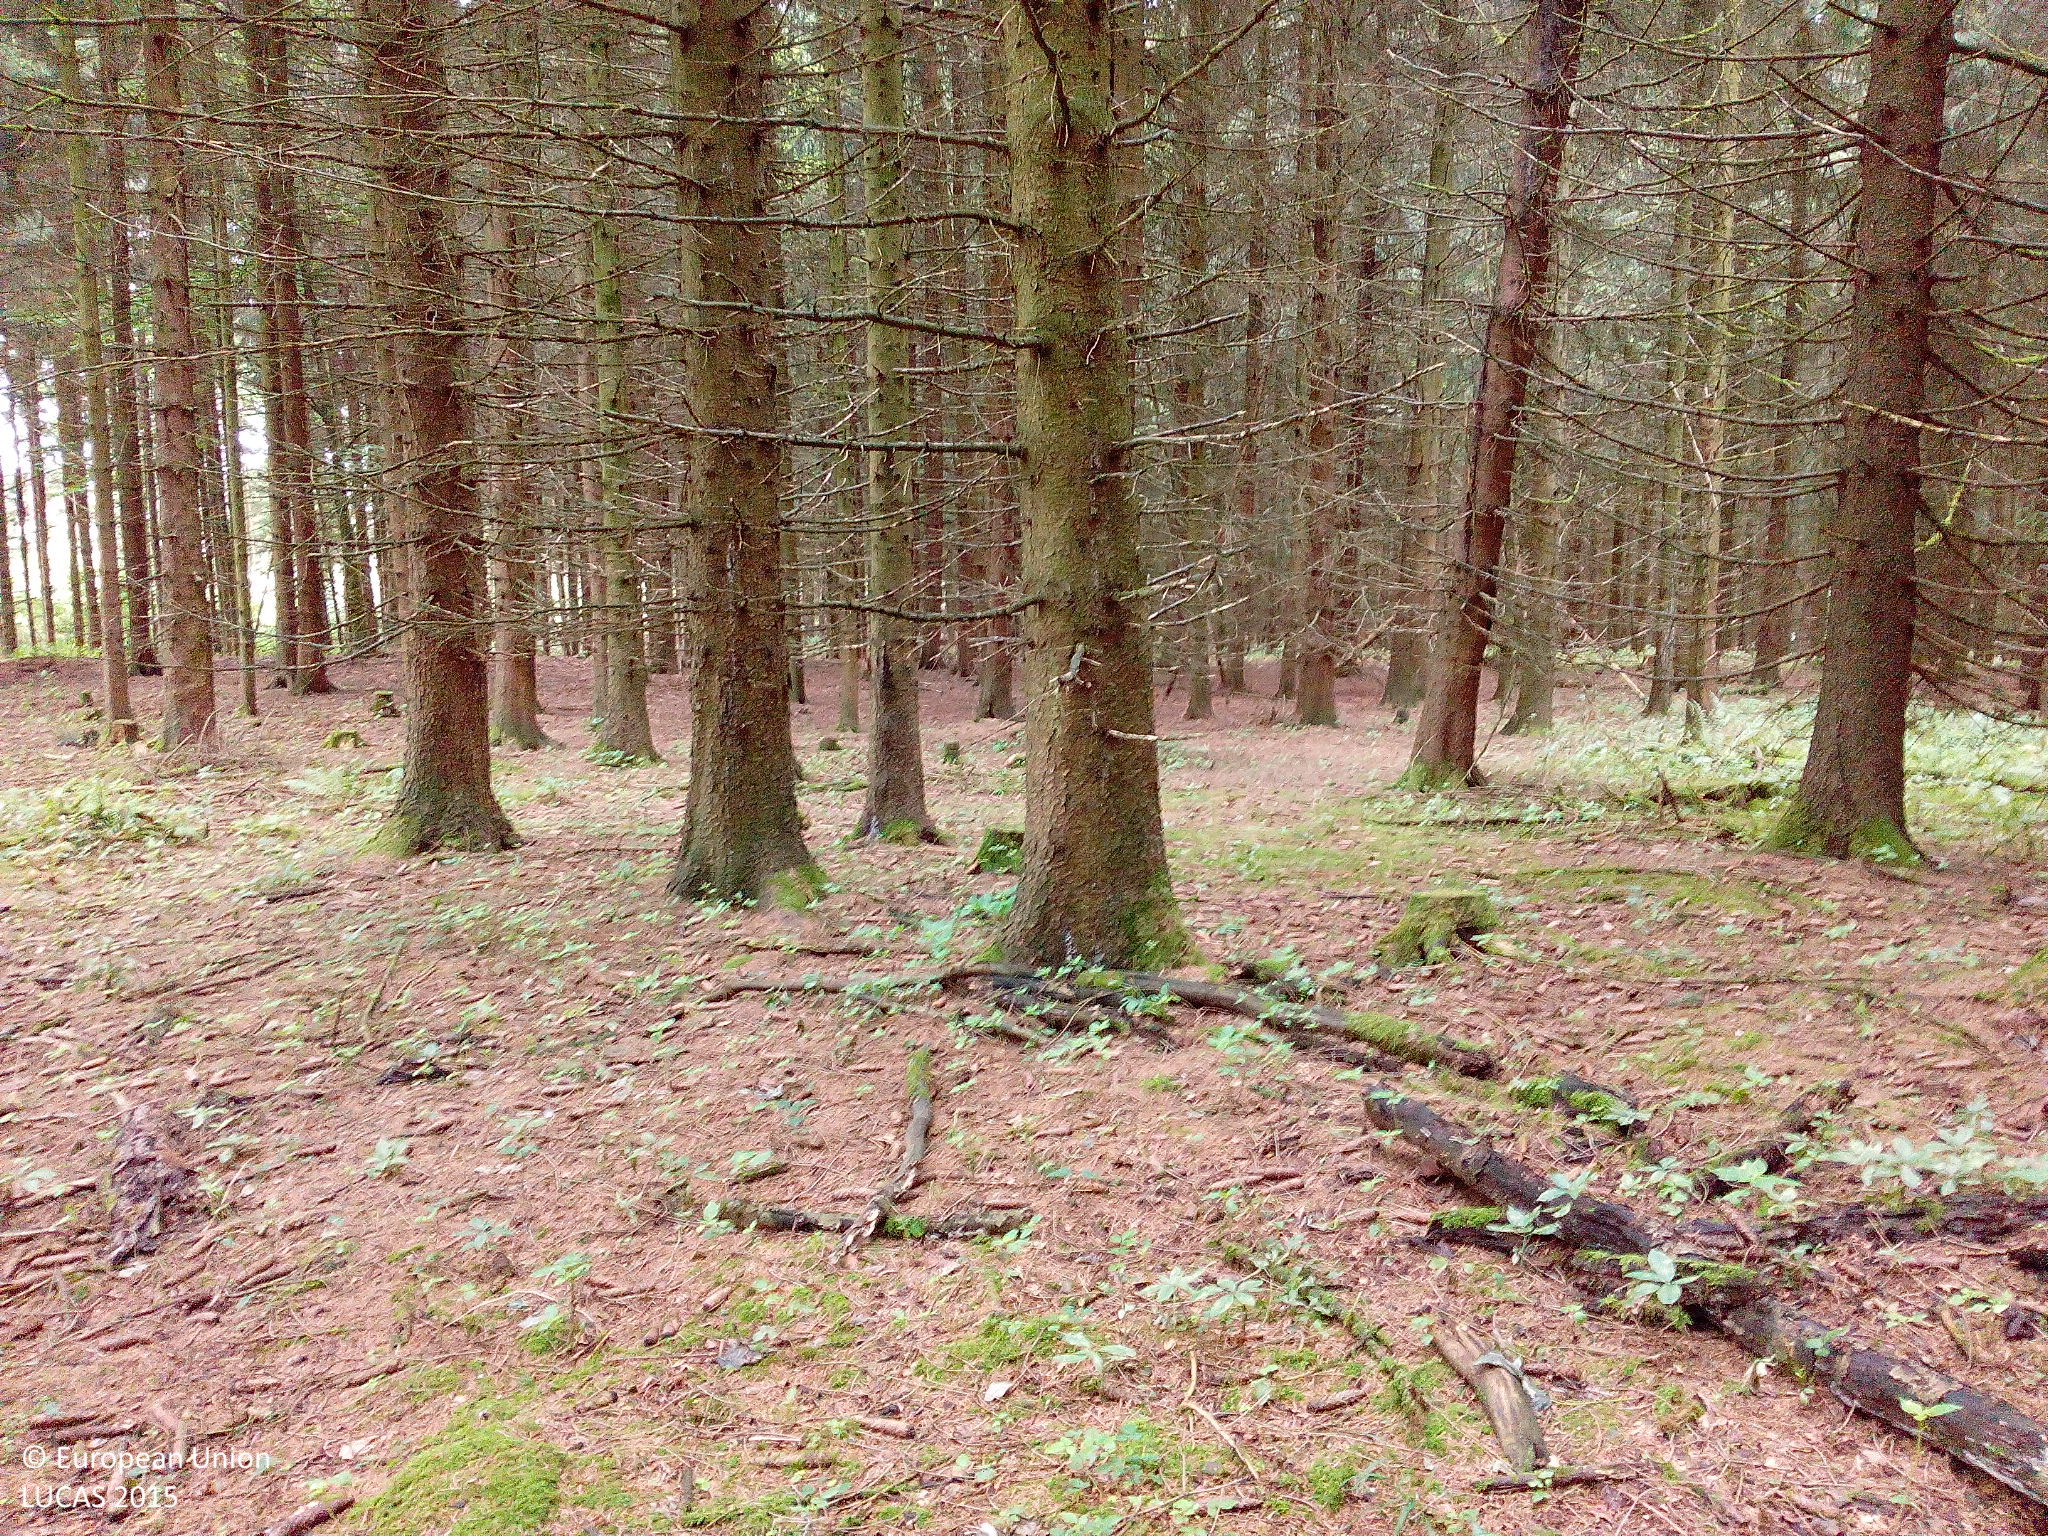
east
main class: Woodland
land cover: Spruce dominated coniferous woodland
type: hemiboreal forest and nemoral coniferous forest and mixed broadleaved-coniferous forest
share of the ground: > 75 %
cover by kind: coniferous forest trees 80 %, broadleaved forest trees 10 %, lichens and mosses 5 %, unconsolidated bare surface 5 %
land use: Forestry
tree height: > 5 m
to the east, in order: Spruce dominated coniferous woodland; Tracks; Shrubland with sparse tree cover
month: August
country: DE
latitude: 50.3976
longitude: 9.2546
